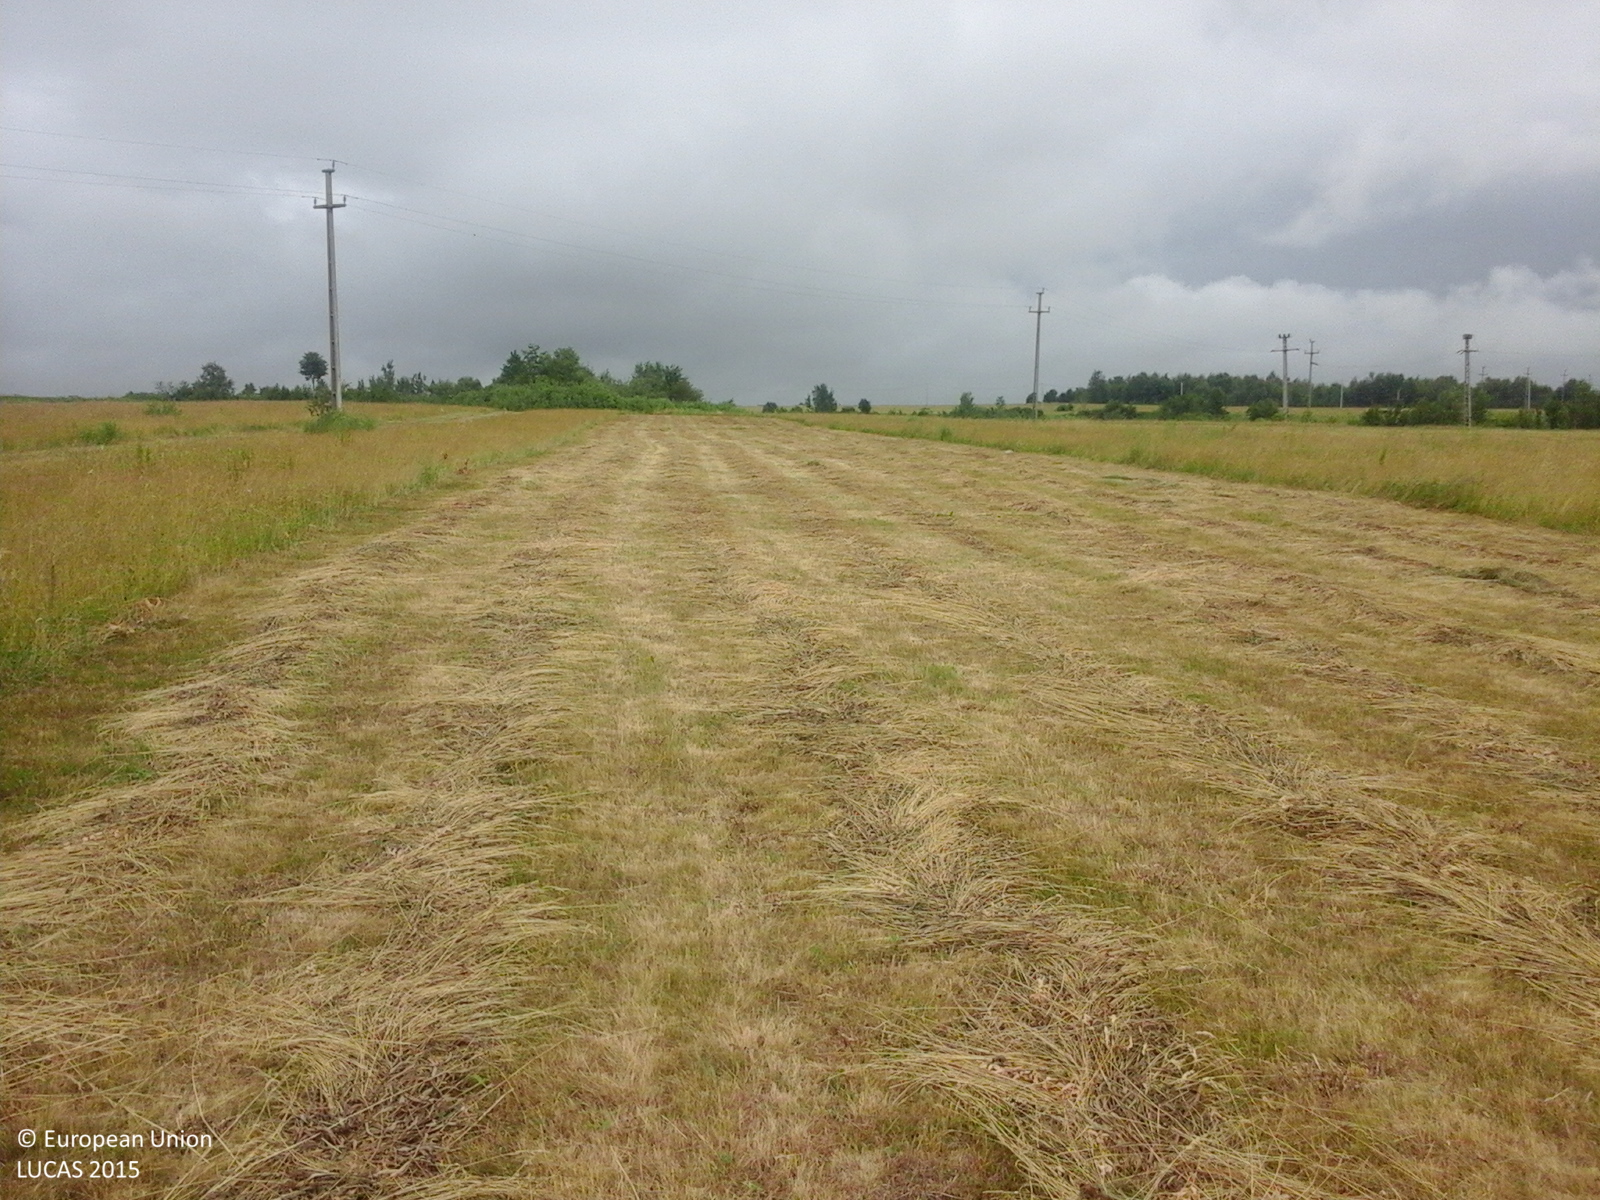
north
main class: Grassland
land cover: Grassland without tree/shrub cover
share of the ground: < 10 %
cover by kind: herbaceous plants 100 %
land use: Agriculture (excluding fallow land and kitchen gardens)
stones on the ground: < 10 %
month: June
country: RO
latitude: 47.2921
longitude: 26.3072
